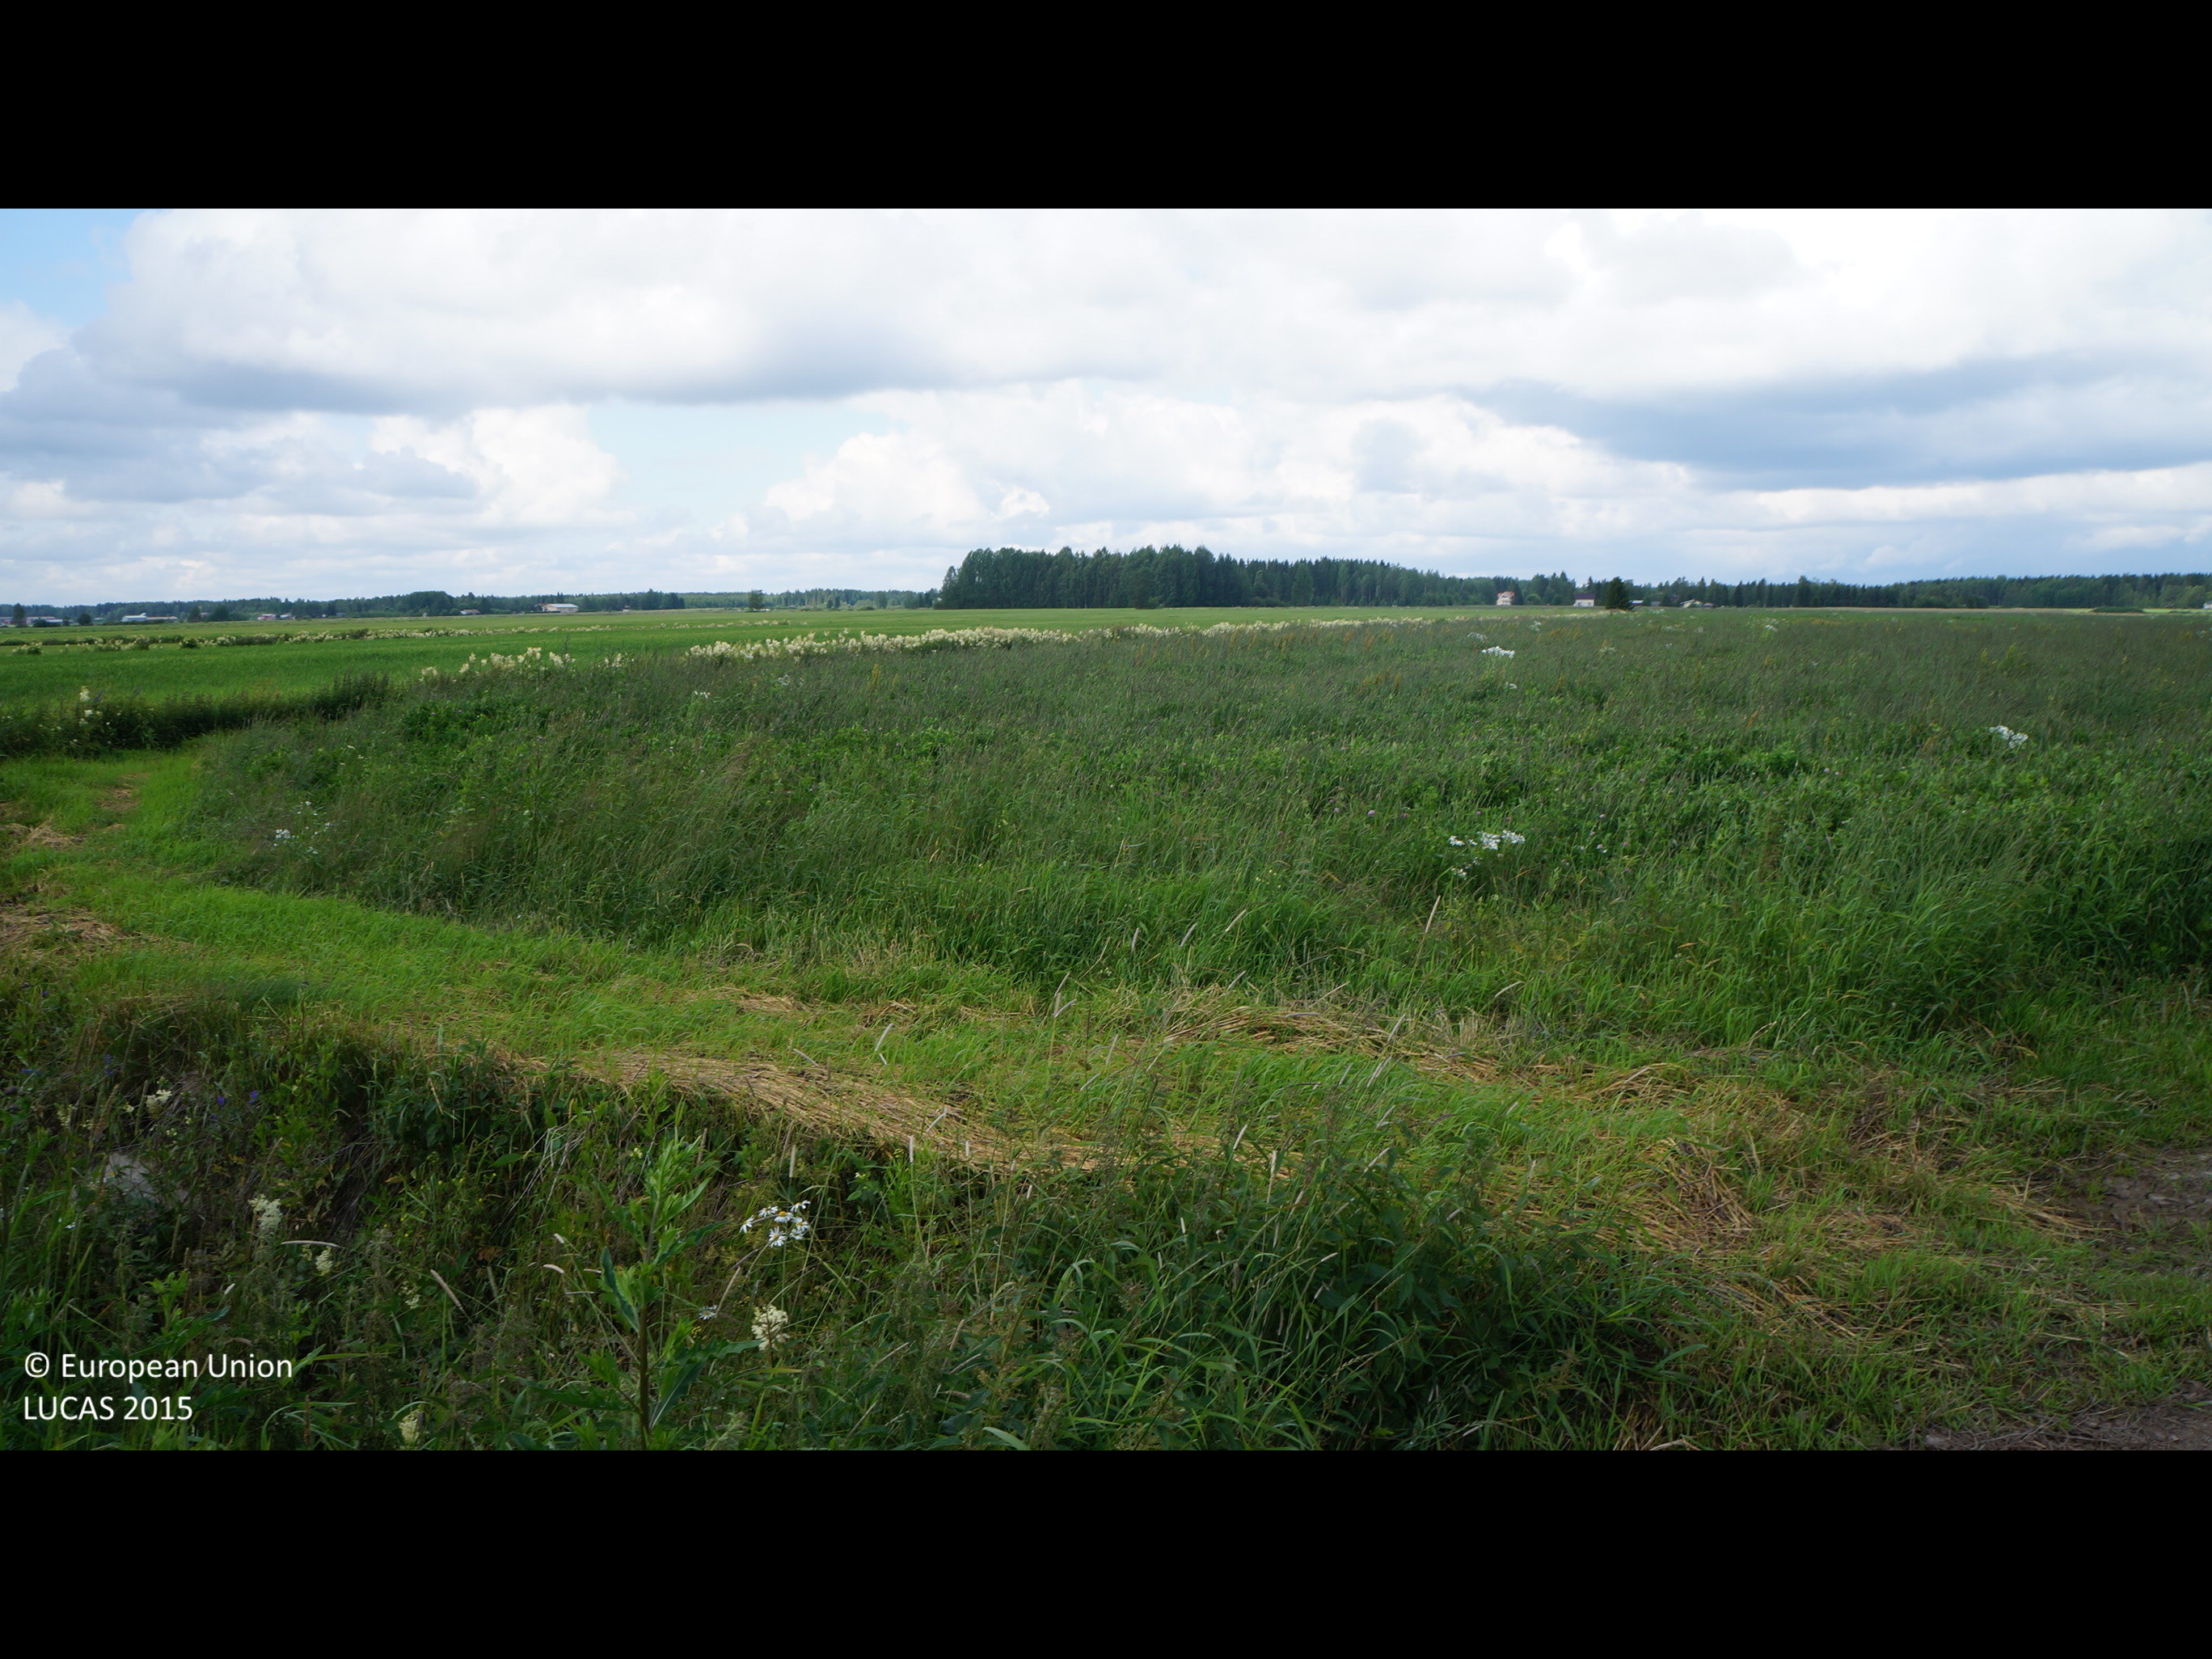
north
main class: Cropland
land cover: Barley
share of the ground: > 75 %
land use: Agriculture (excluding fallow land and kitchen gardens)
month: July
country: FI
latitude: 63.8562
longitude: 25.0797
